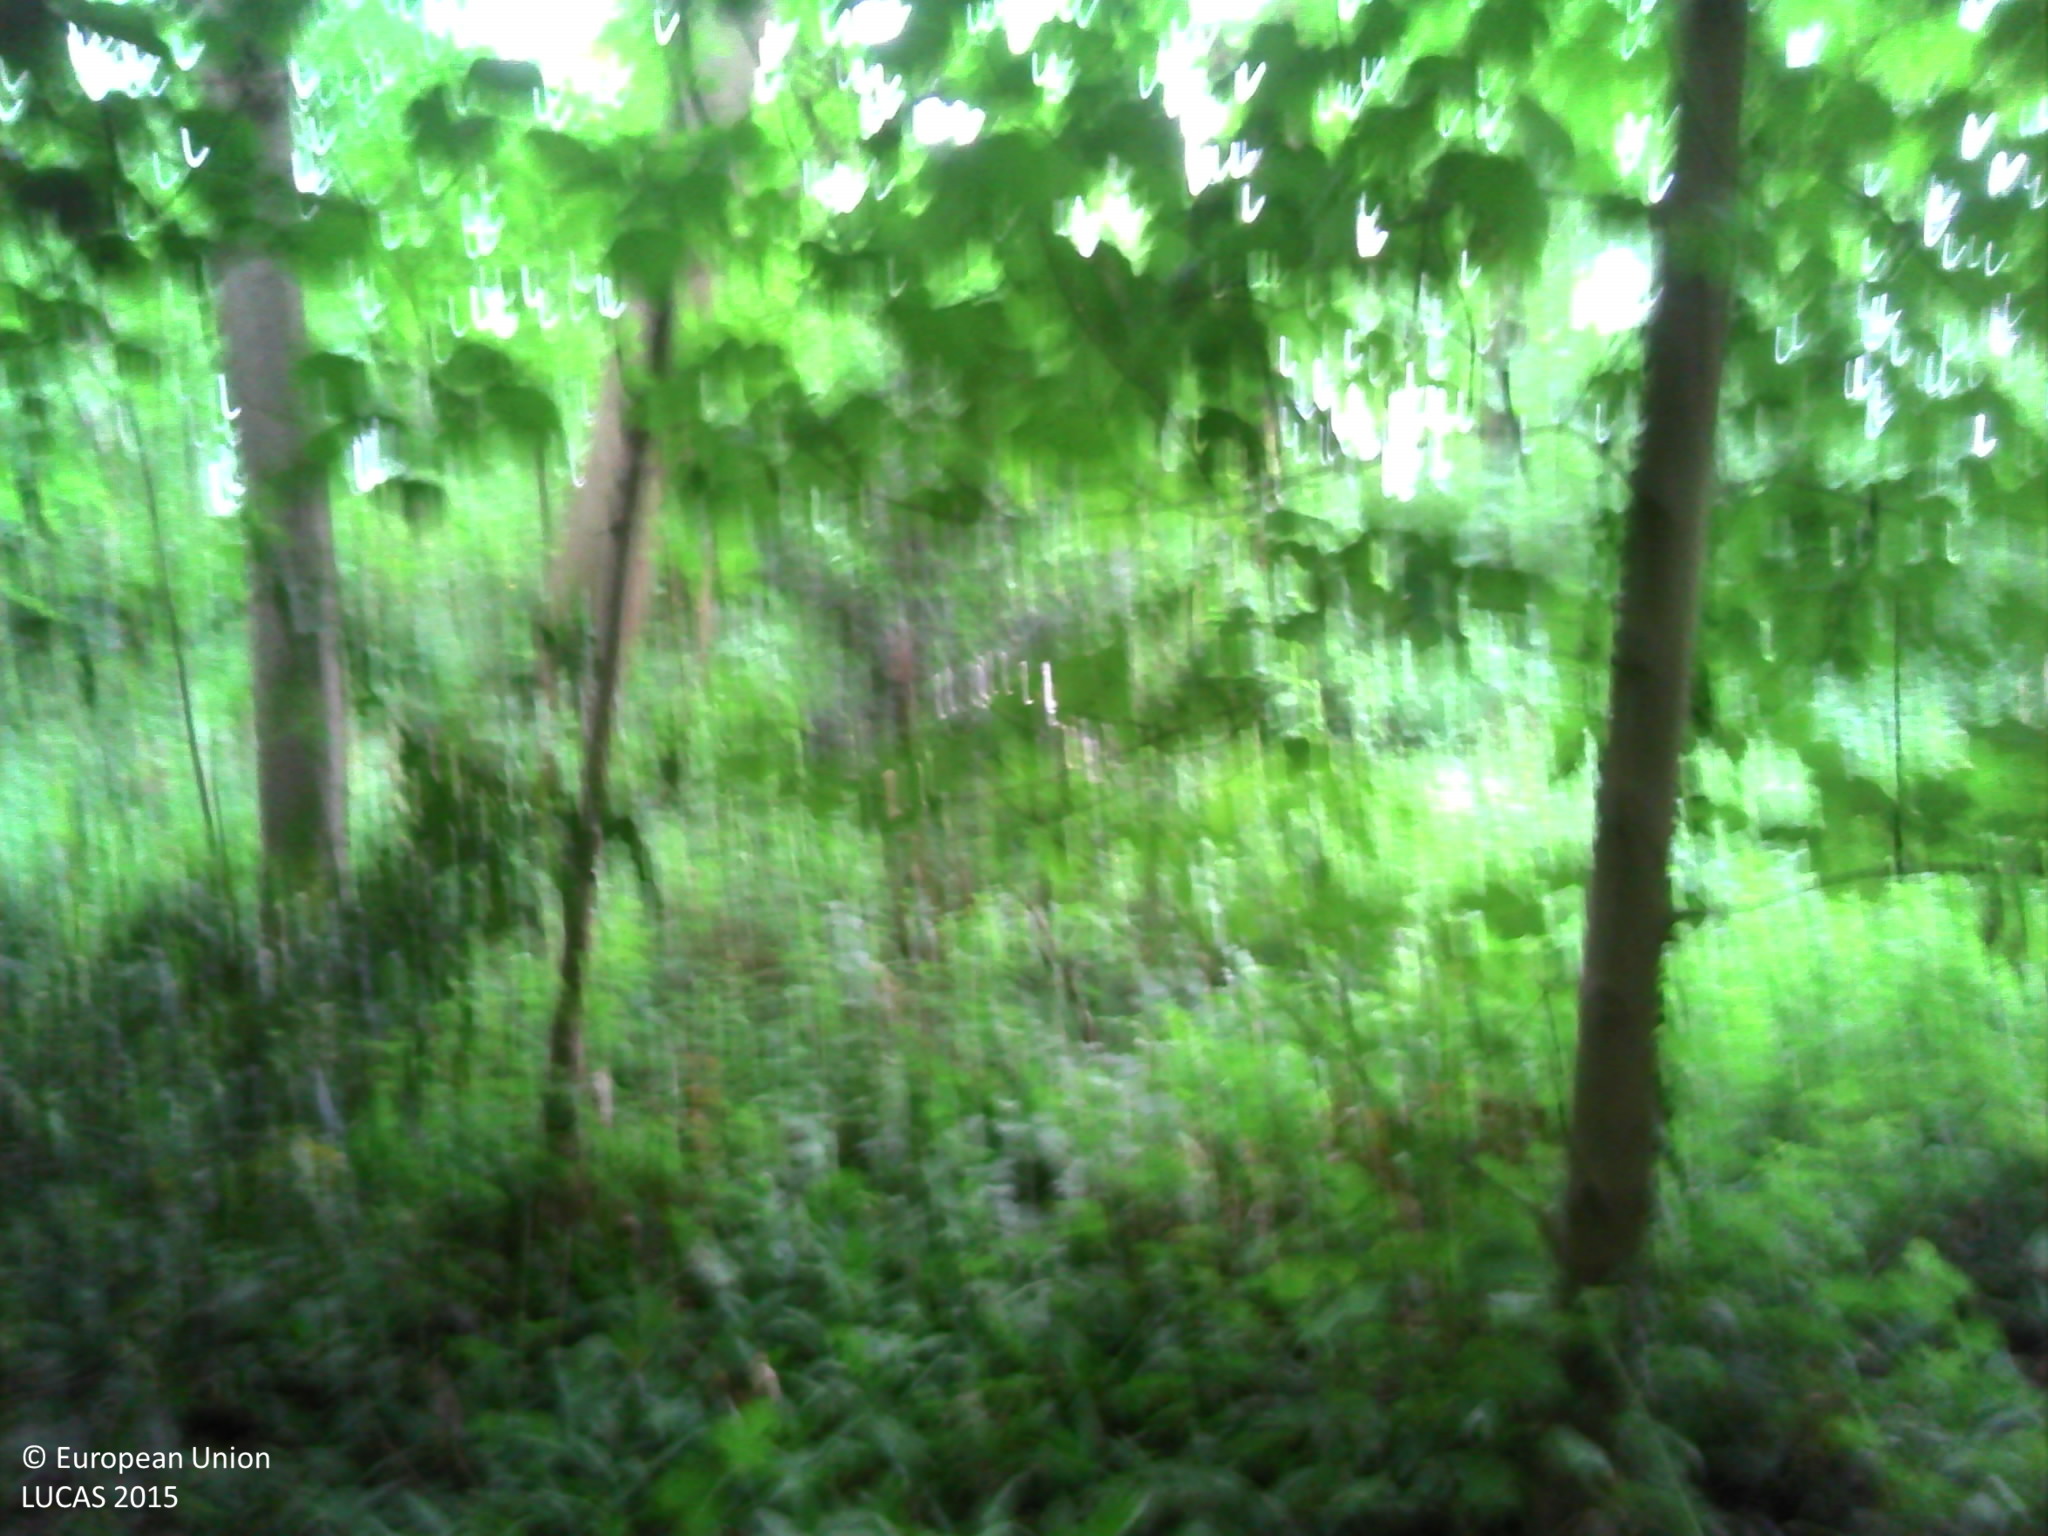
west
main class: Woodland
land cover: Broadleaved woodland
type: mesophytic deciduous forest
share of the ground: > 75 %
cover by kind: broadleaved forest trees 100 %
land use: Forestry
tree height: > 5 m
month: May
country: BE
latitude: 50.7038
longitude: 4.5729
